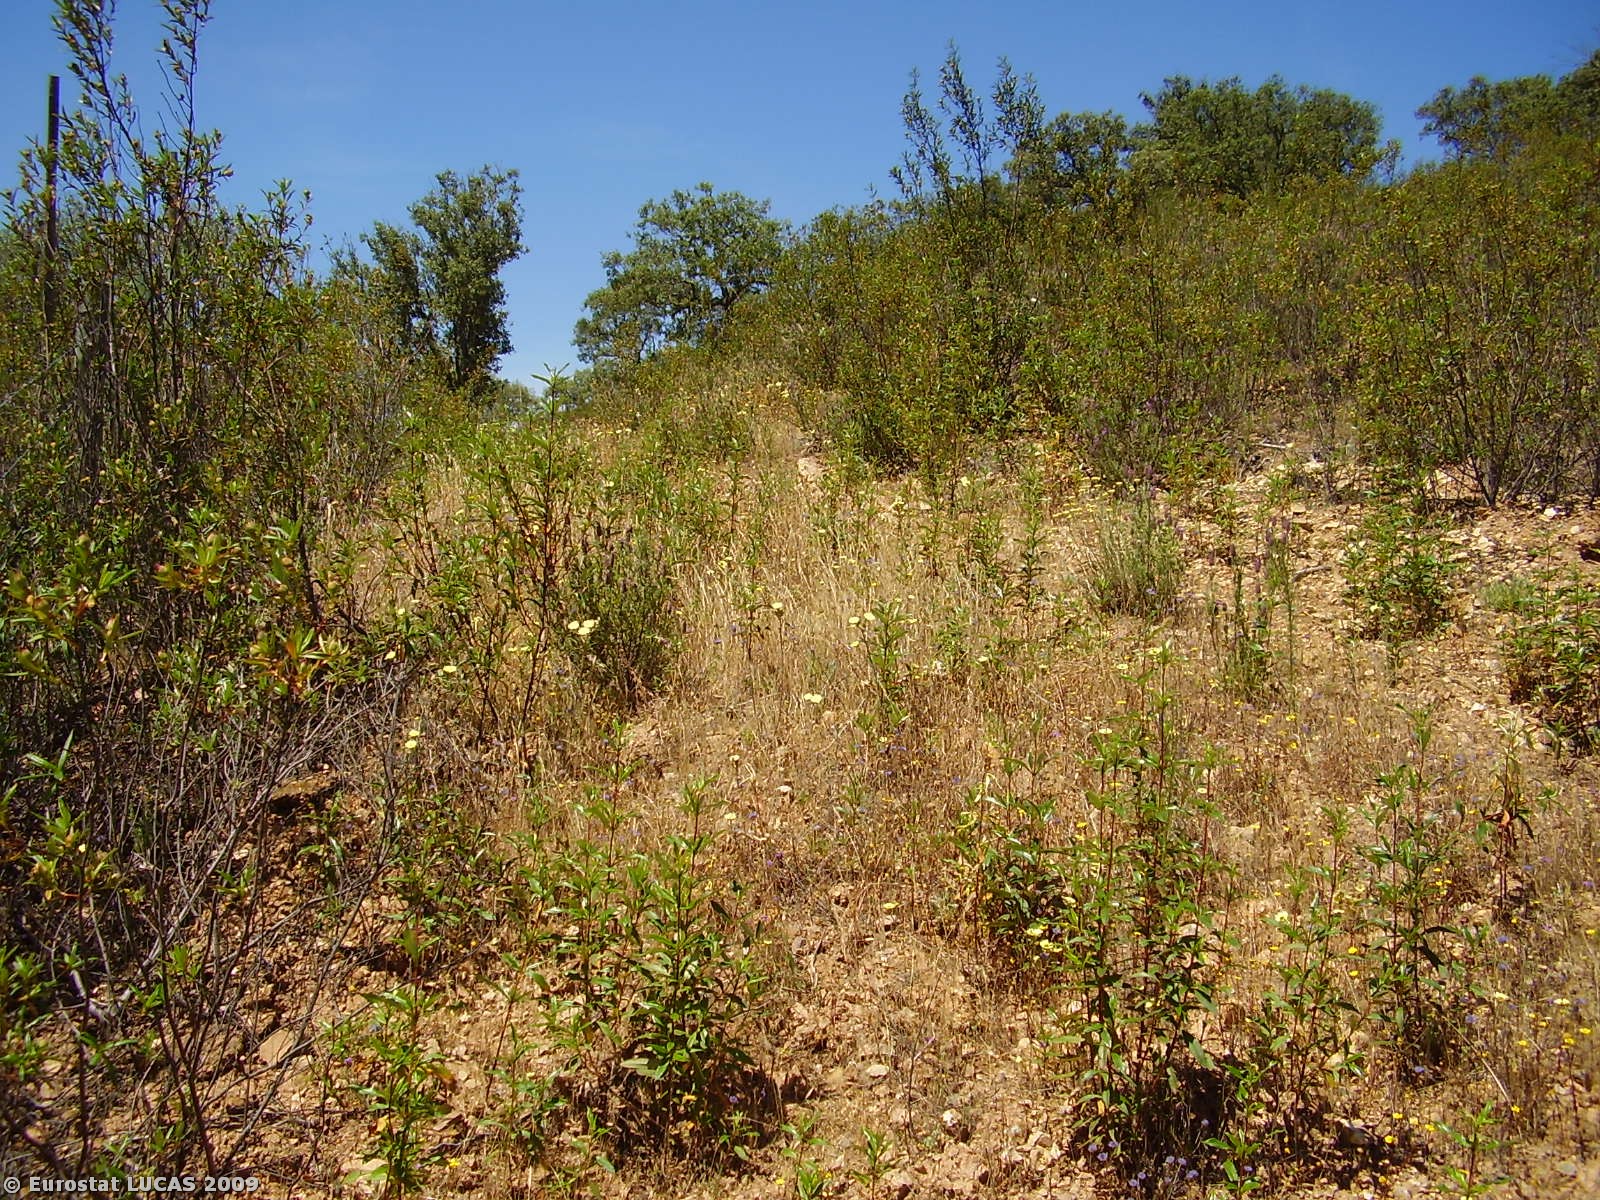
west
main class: Shrubland
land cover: Shrubland with sparse tree cover
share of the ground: > 75 %
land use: Fallow land
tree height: > 5 m
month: May
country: PT
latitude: 37.4938
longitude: -8.2011
